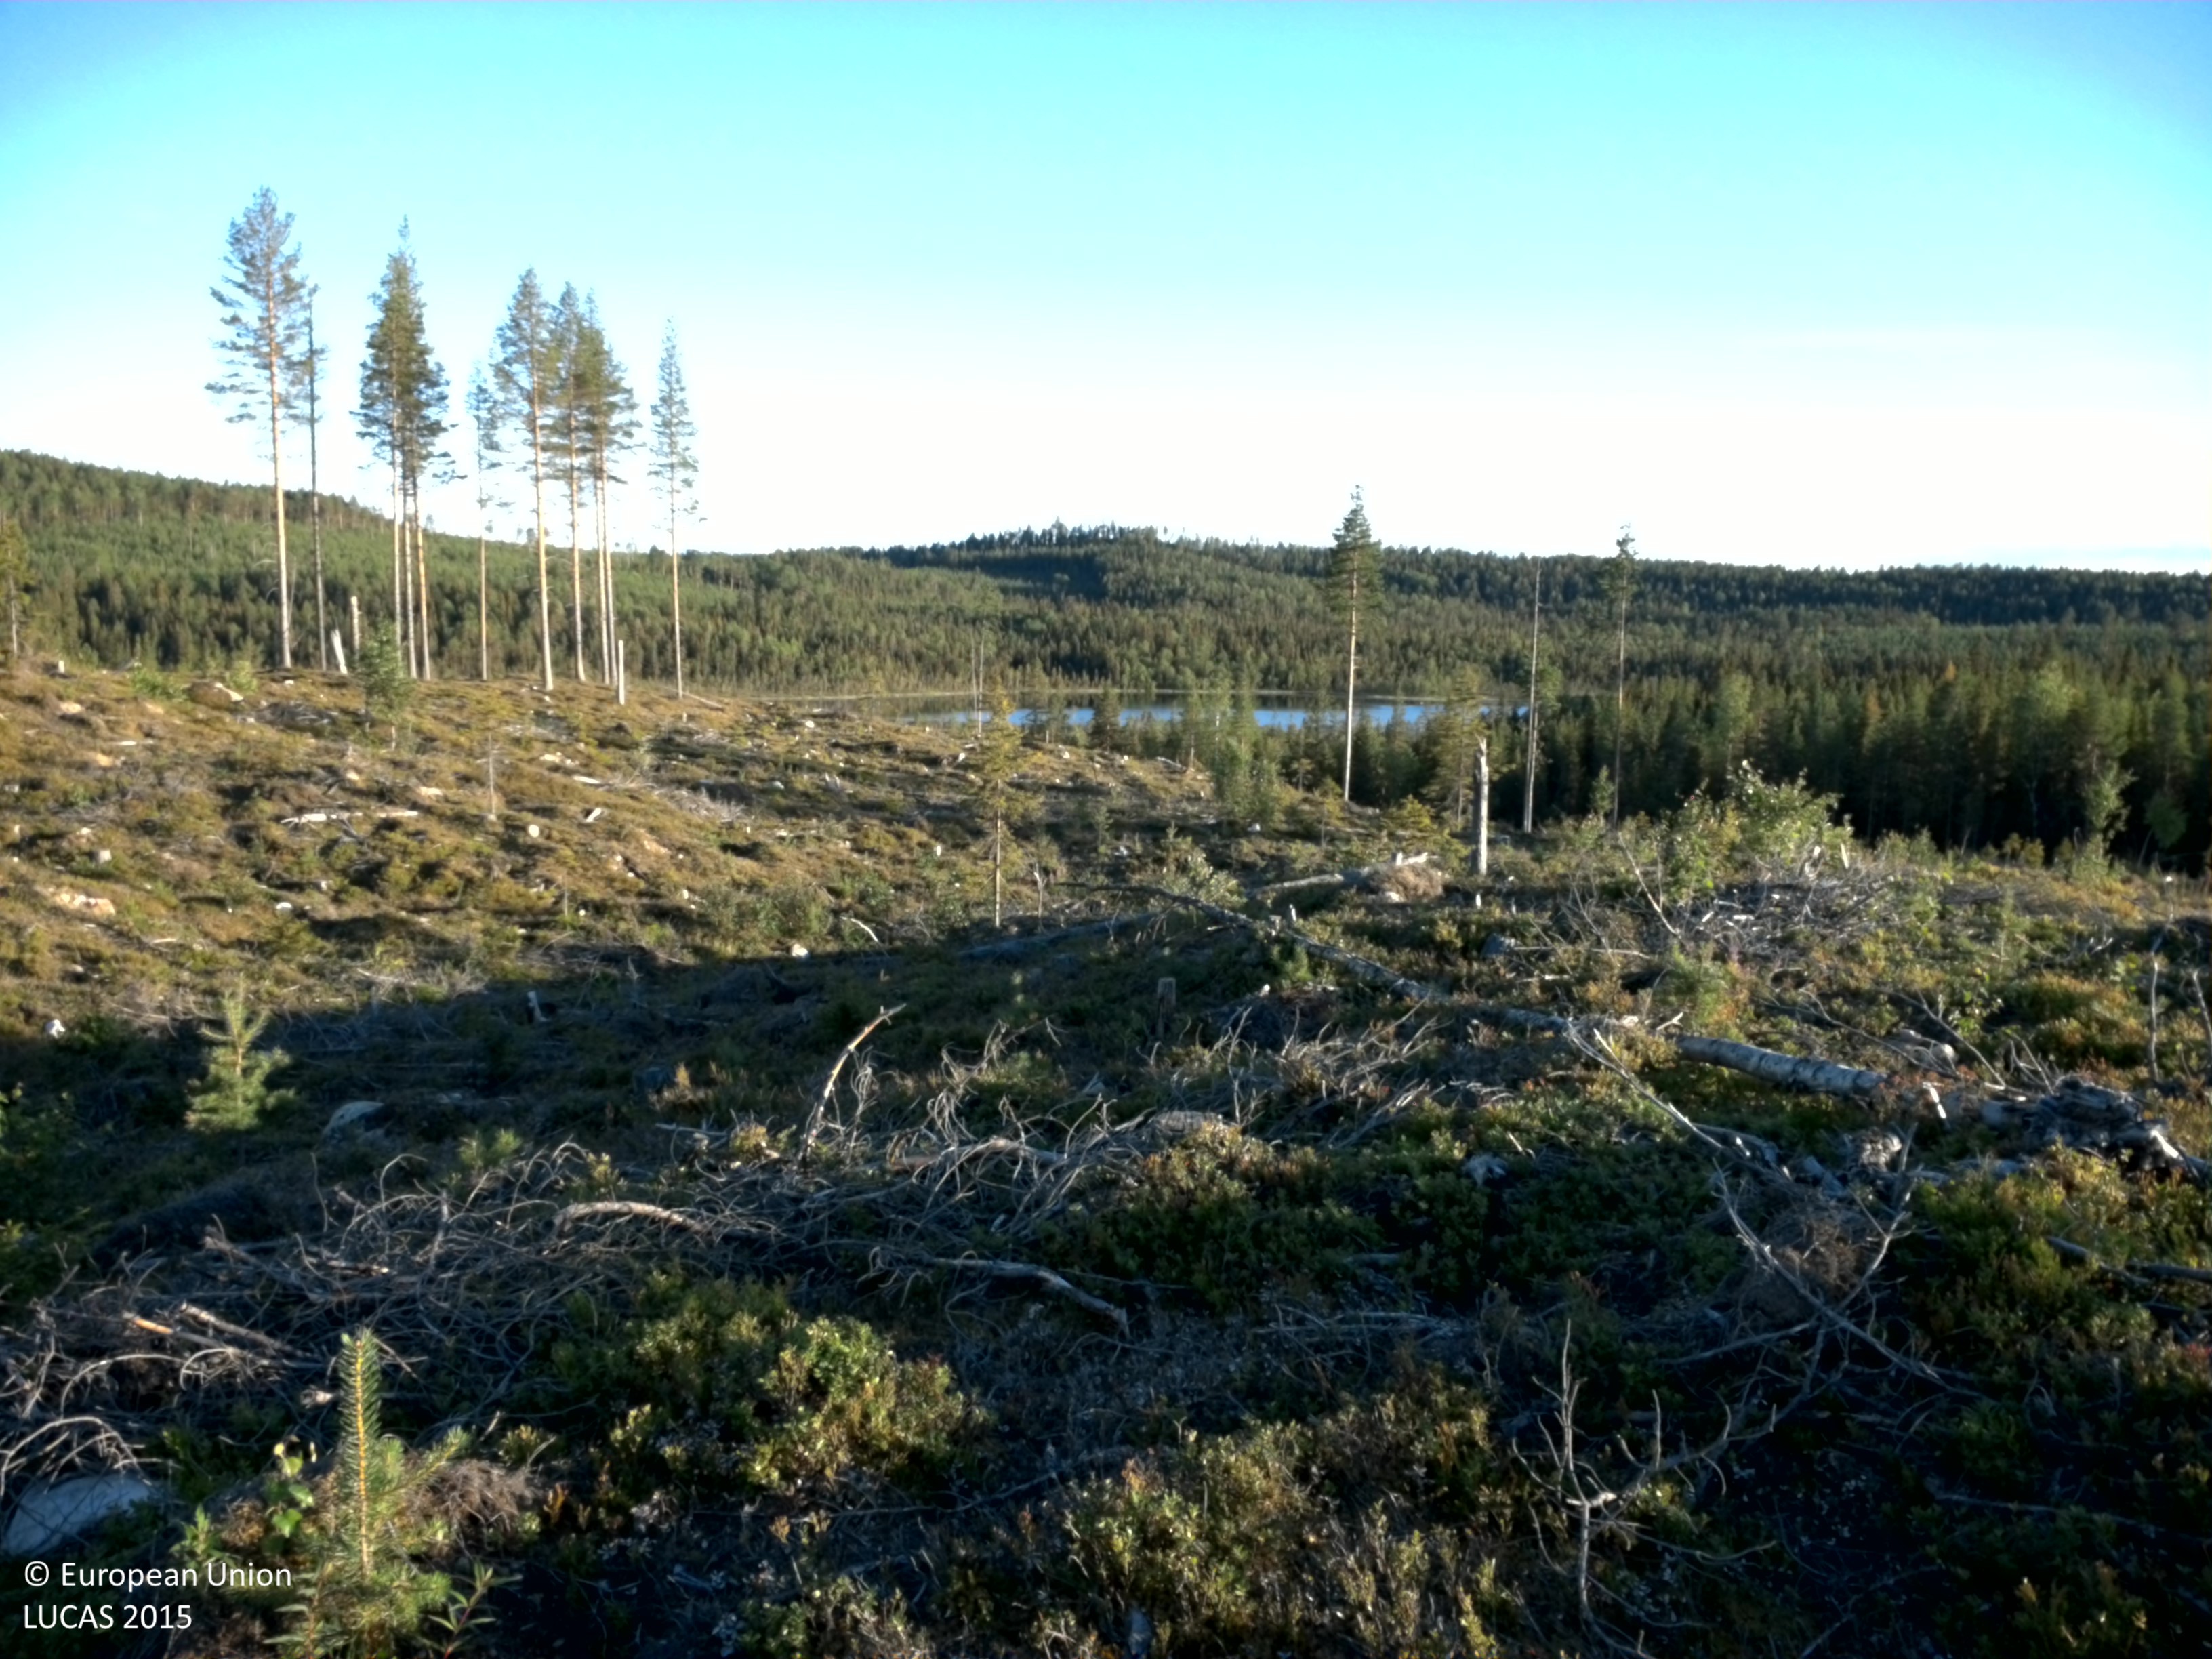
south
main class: Shrubland
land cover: Shrubland with sparse tree cover
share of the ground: > 75 %
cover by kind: shrubs 80 %, broadleaved forest trees 5 %, lichens and mosses 5 %, consolidated bare surface 5 %, unconsolidated bare surface 5 %
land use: Forestry
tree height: < 5 m
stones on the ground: 25 - 50 %
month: August
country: SE
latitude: 66.3590
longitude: 20.6632
